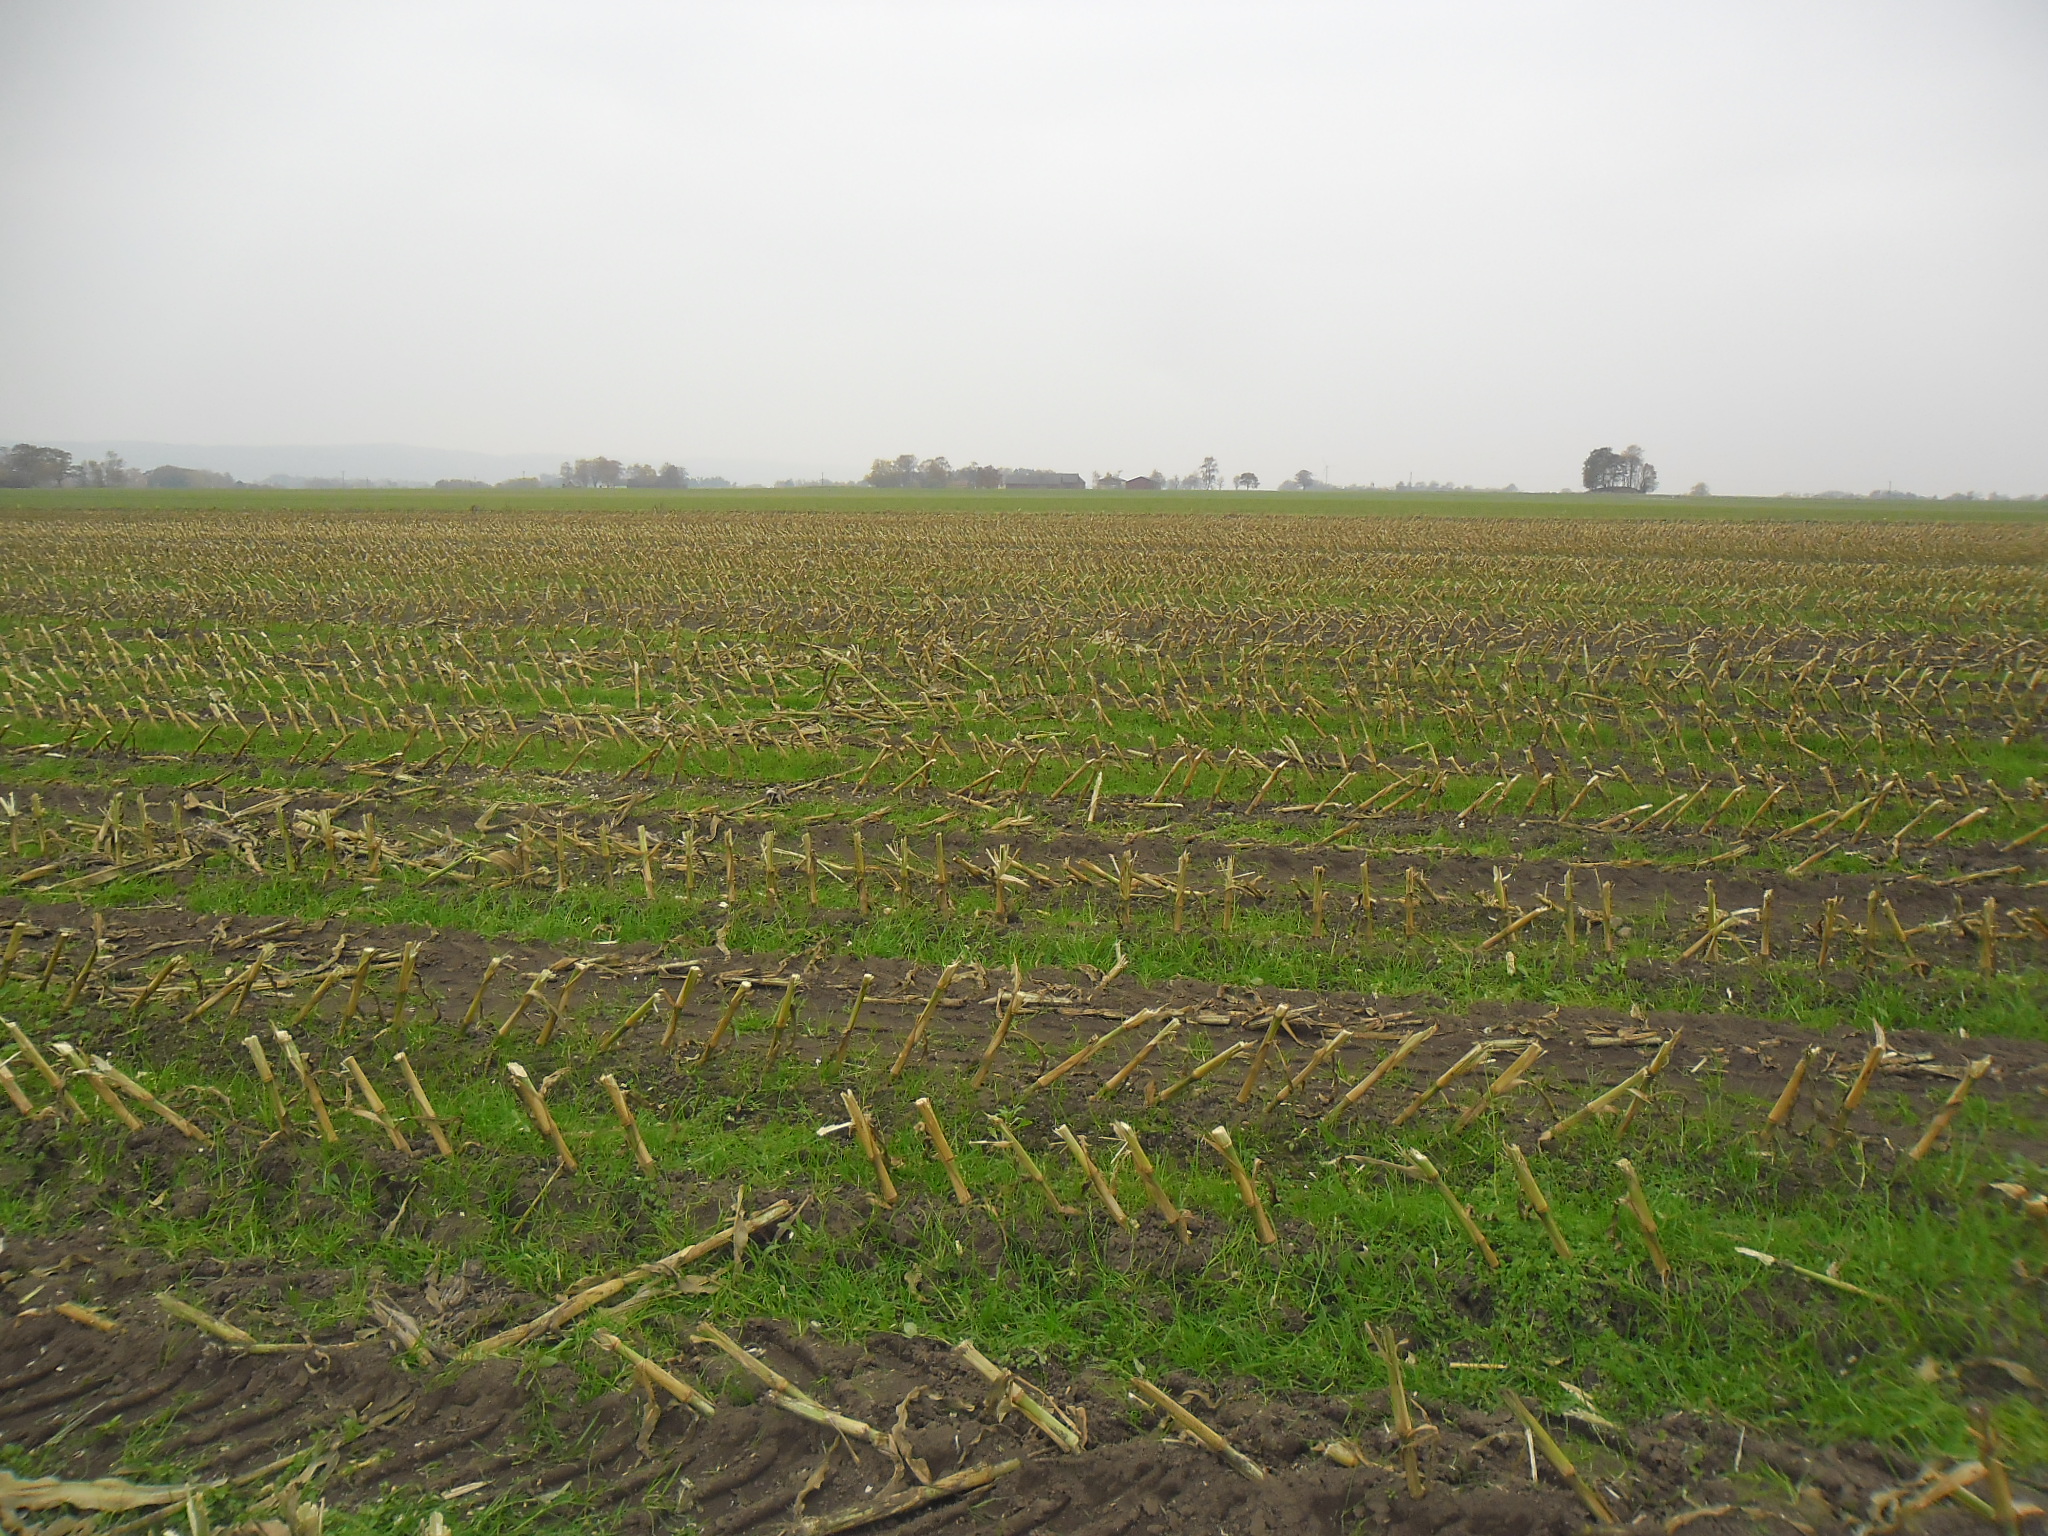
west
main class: Cropland
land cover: Maize
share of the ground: < 10 %
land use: Agriculture (excluding fallow land and kitchen gardens)
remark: Harvested field
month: October
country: SE
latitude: 56.4383
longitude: 13.0949
